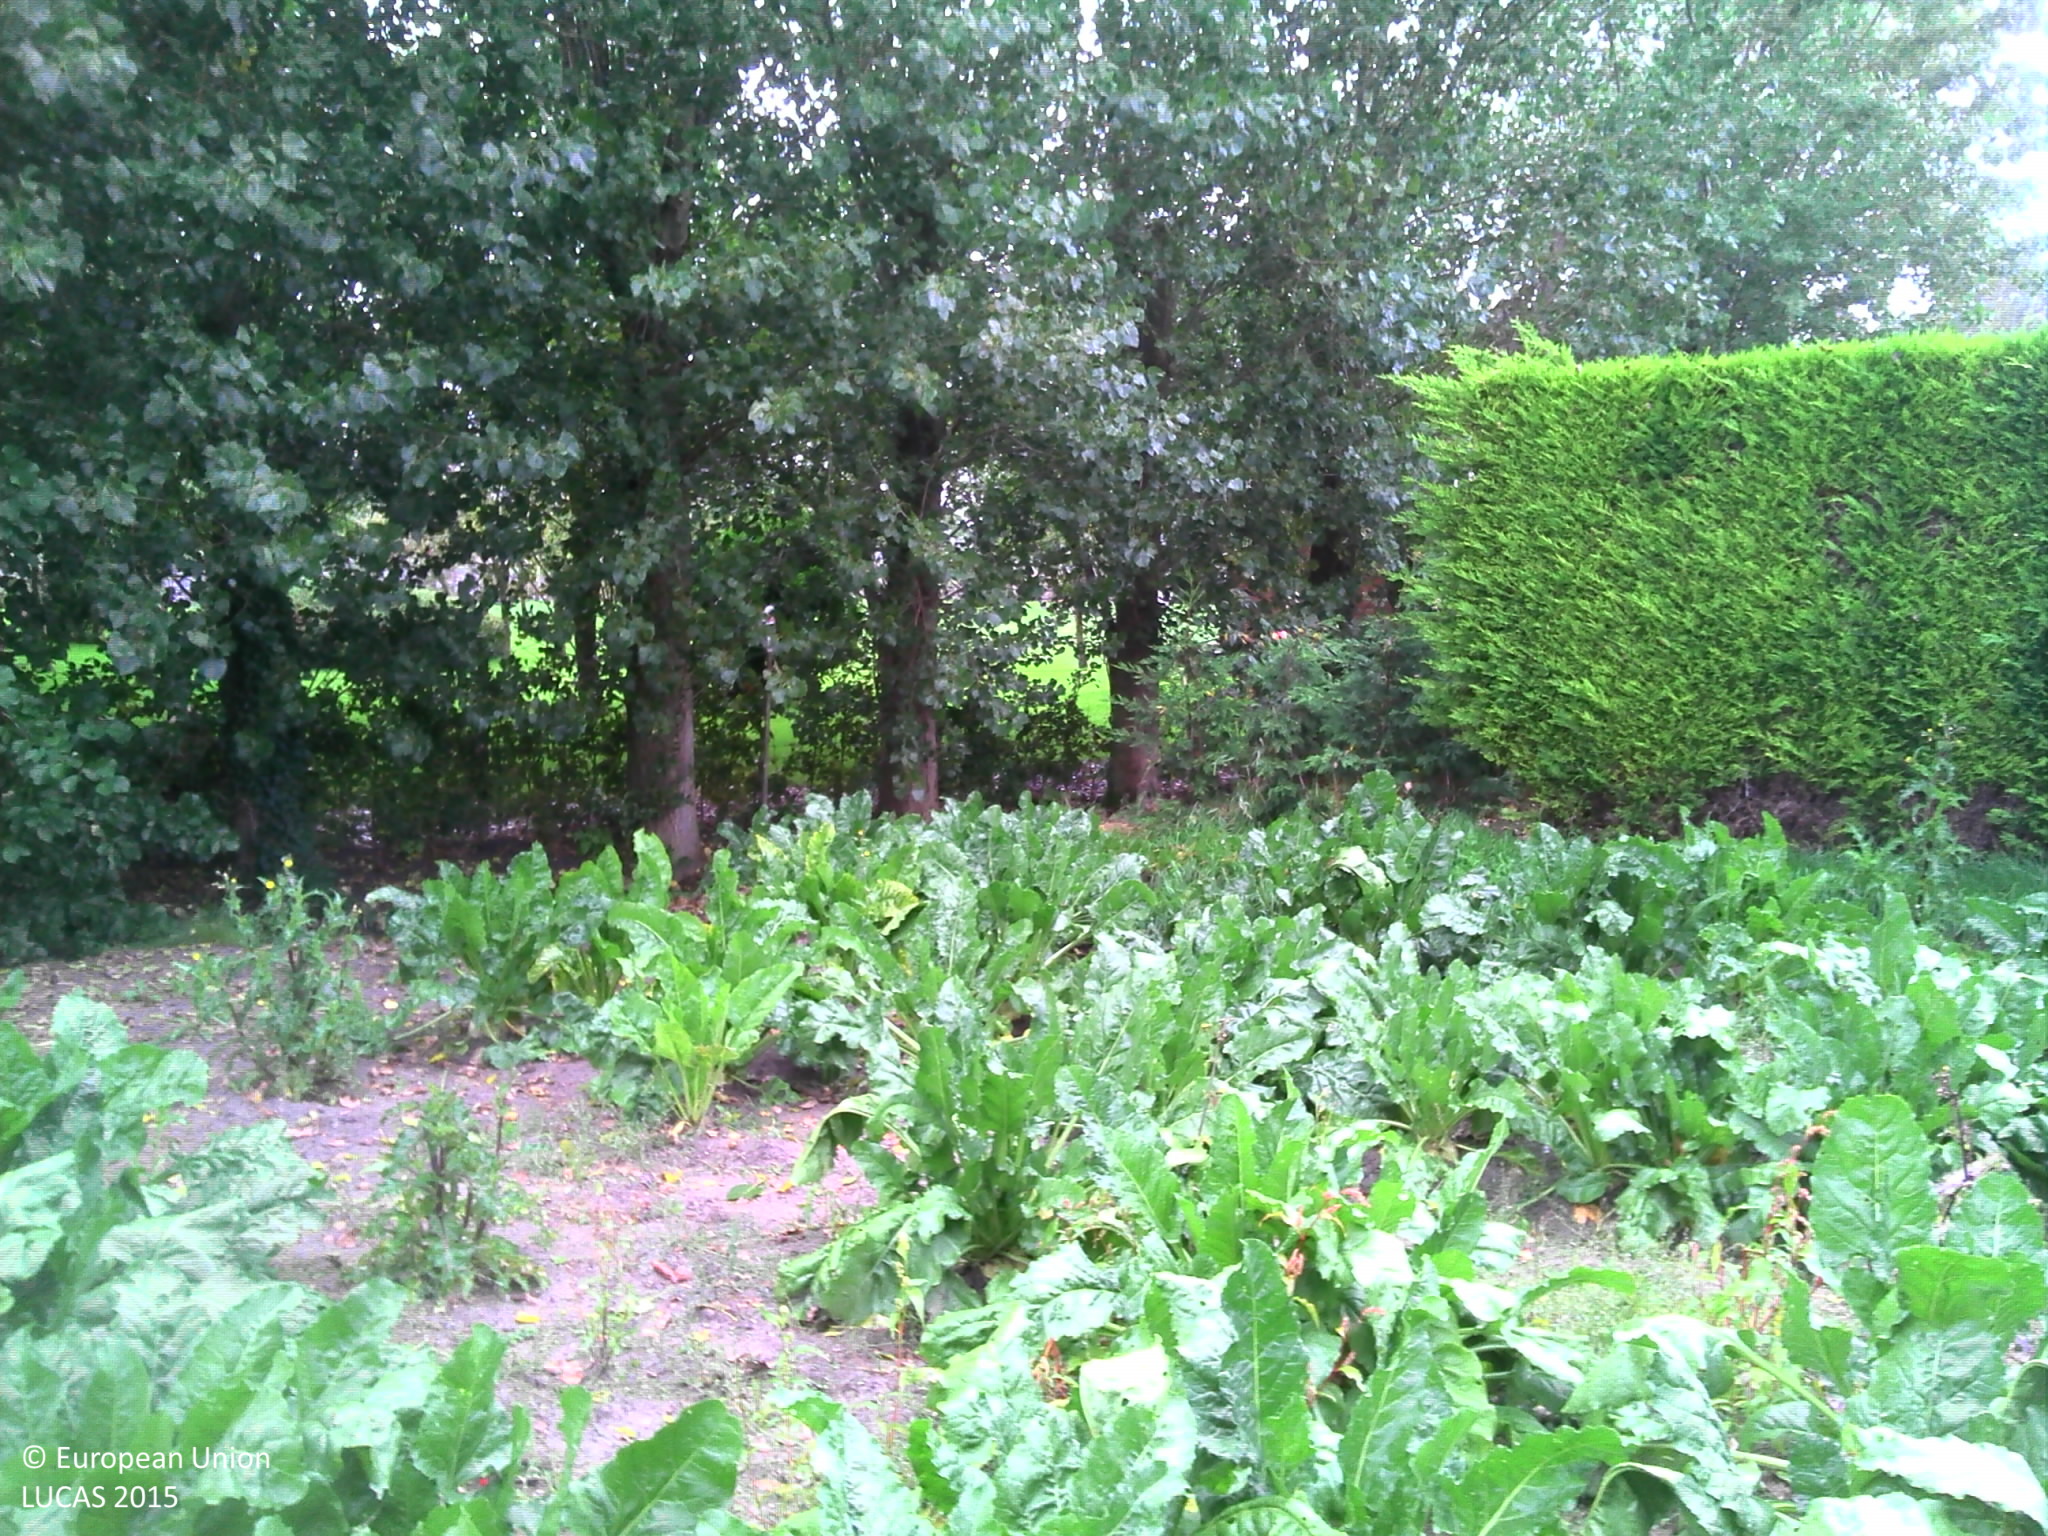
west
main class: Cropland
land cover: Sugar beet
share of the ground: > 75 %
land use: Agriculture (excluding fallow land and kitchen gardens)
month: September
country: BE
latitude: 51.1103
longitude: 2.7754
